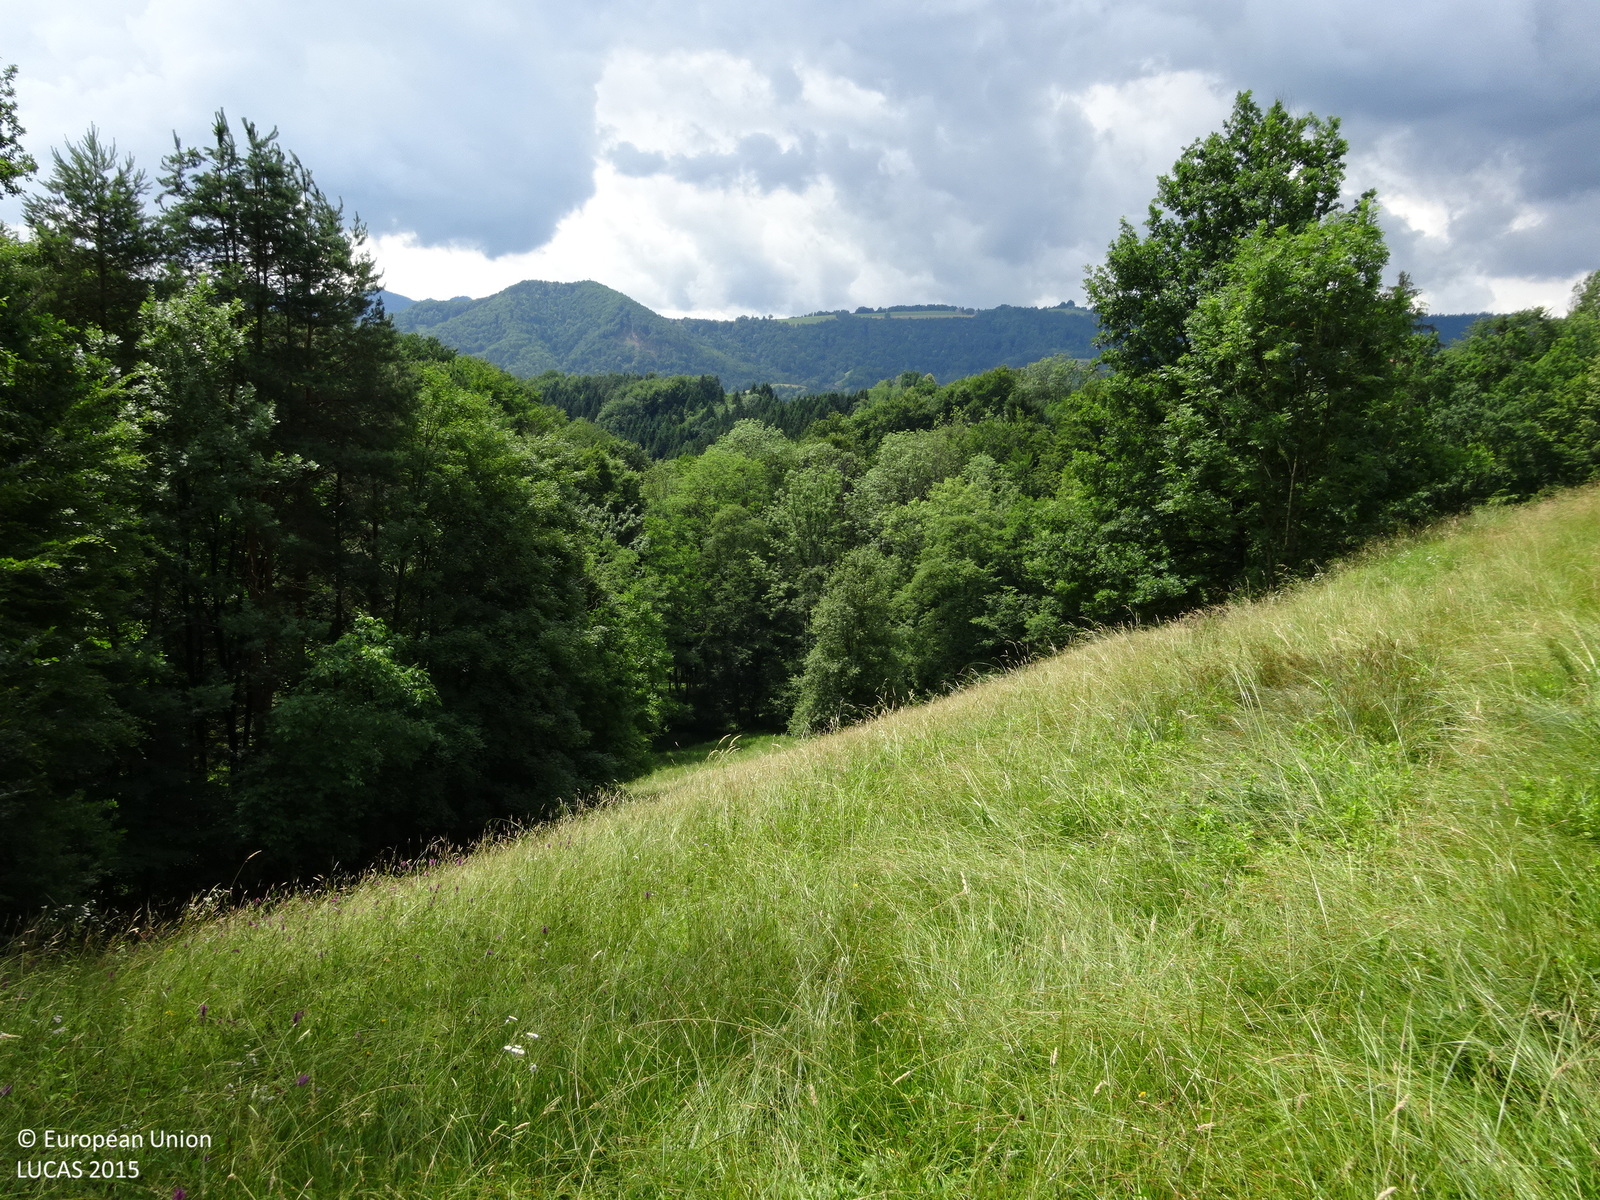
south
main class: Grassland
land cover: Grassland without tree/shrub cover
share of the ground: > 75 %
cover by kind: herbaceous plants 100 %
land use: Agriculture (excluding fallow land and kitchen gardens)
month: June
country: AT
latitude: 46.6815
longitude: 15.4508
